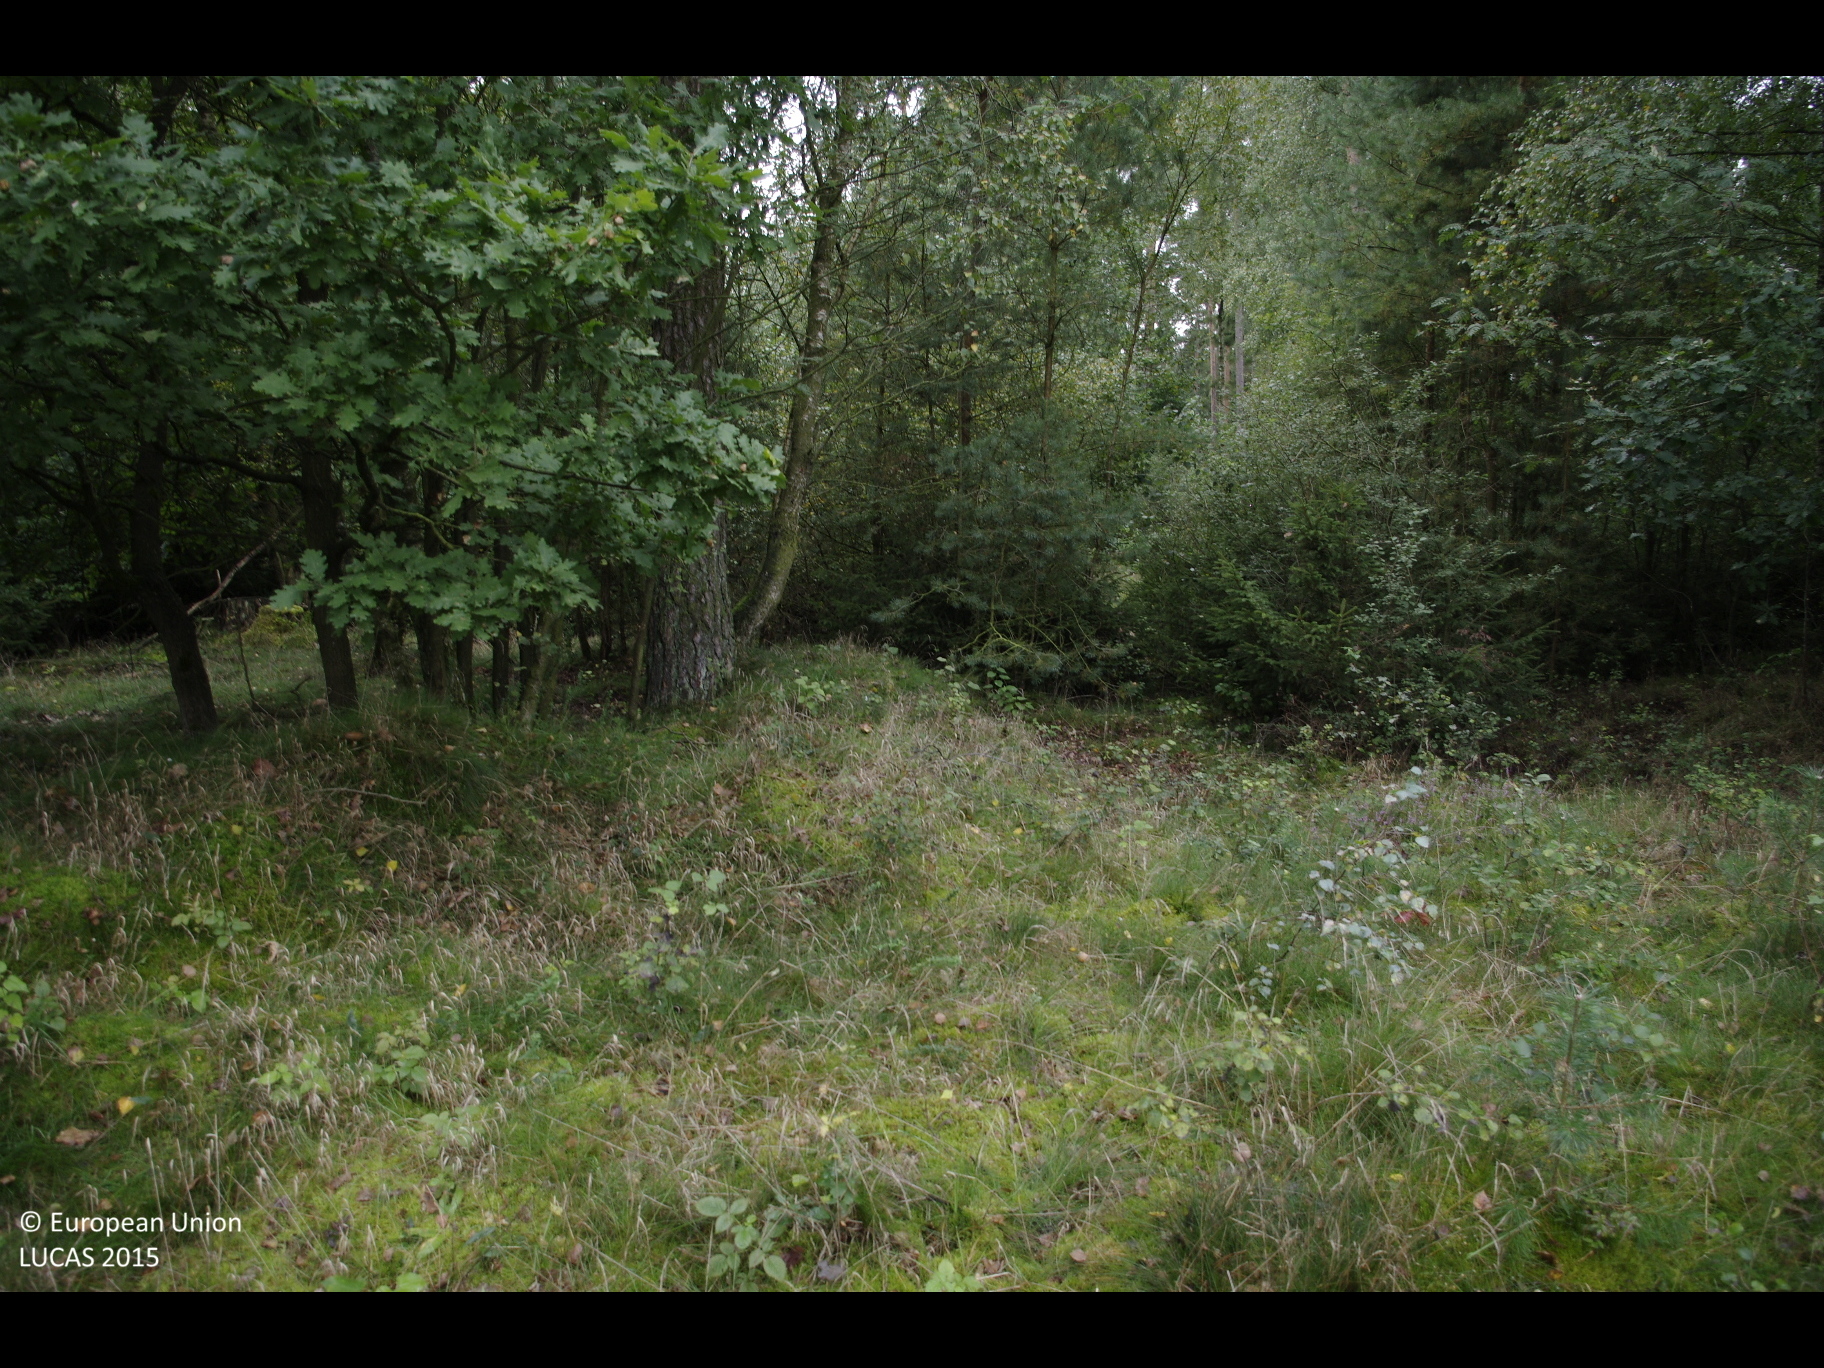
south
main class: Woodland
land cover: Pine dominated mixed woodland
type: hemiboreal forest and nemoral coniferous forest and mixed broadleaved-coniferous forest
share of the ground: > 75 %
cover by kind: coniferous forest trees 50 %, broadleaved forest trees 30 %, herbaceous plants 20 %
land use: Forestry
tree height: > 5 m
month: September
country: DE
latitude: 53.0964
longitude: 9.9254
